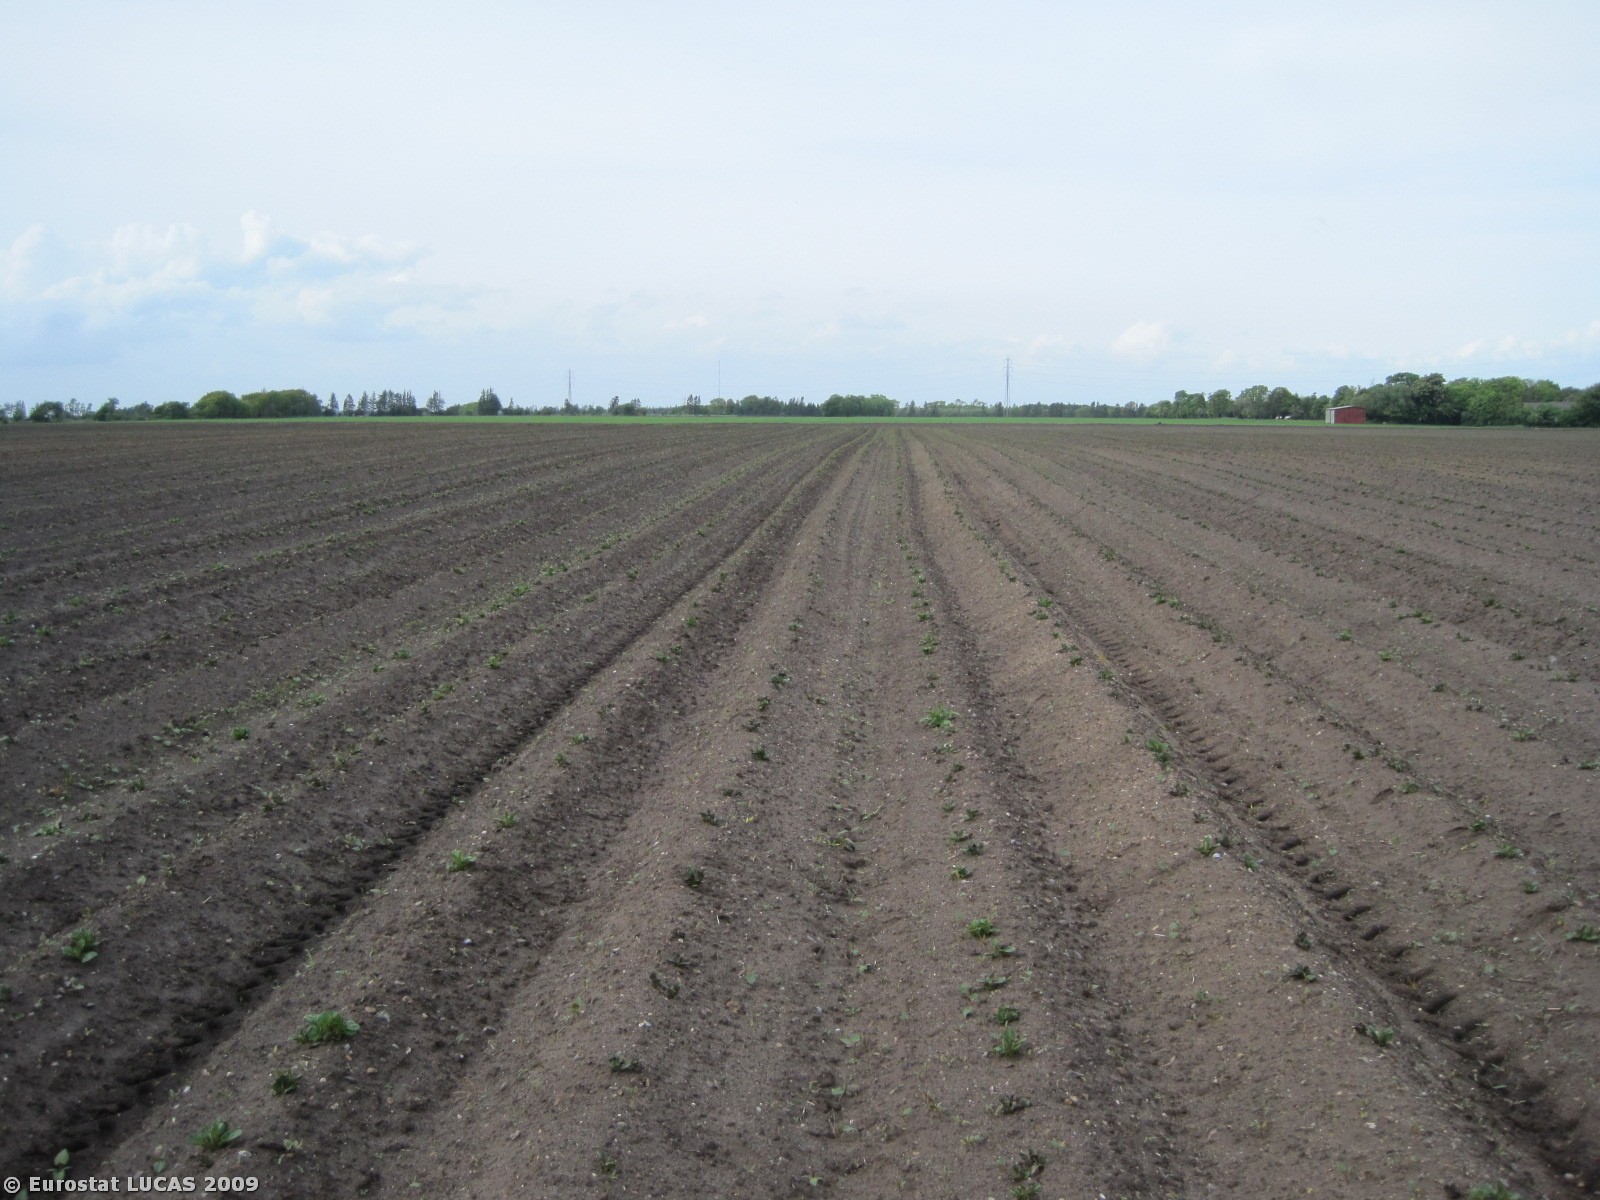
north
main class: Cropland
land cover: Potatoes
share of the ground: < 10 %
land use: Agriculture (excluding fallow land and kitchen gardens)
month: May
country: DK
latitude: 56.3830
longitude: 9.2074
